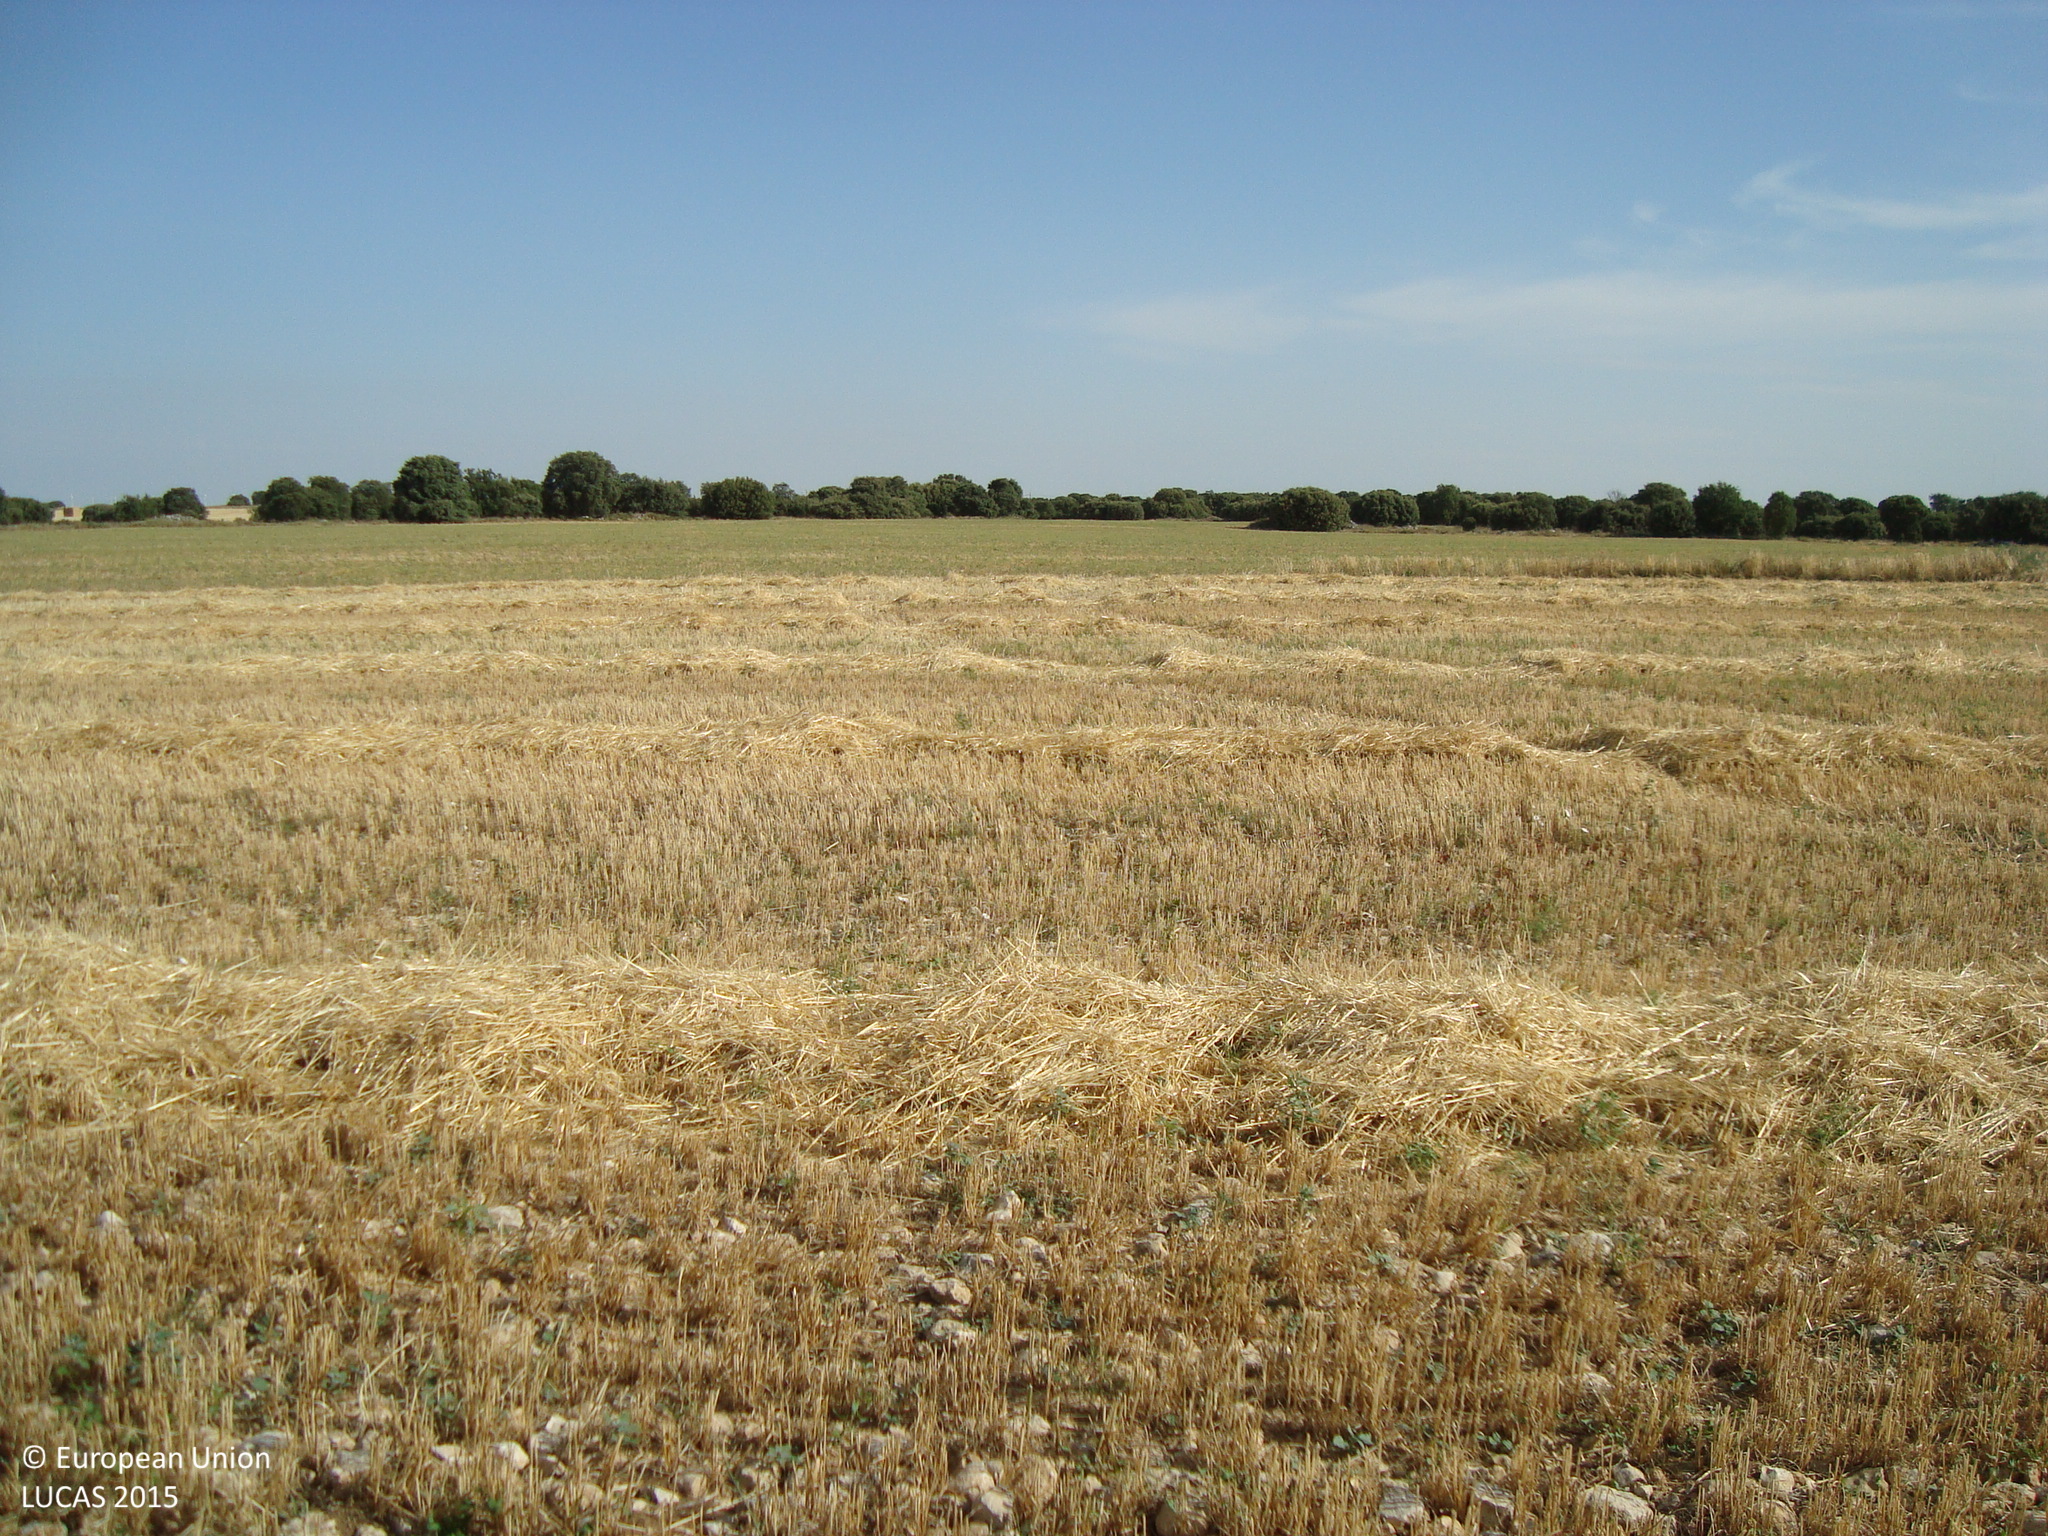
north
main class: Cropland
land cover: Dry pulses
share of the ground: 50 - 75 %
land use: Agriculture (excluding fallow land and kitchen gardens)
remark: Harvested field
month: July
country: ES
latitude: 41.8859
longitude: -4.1993
